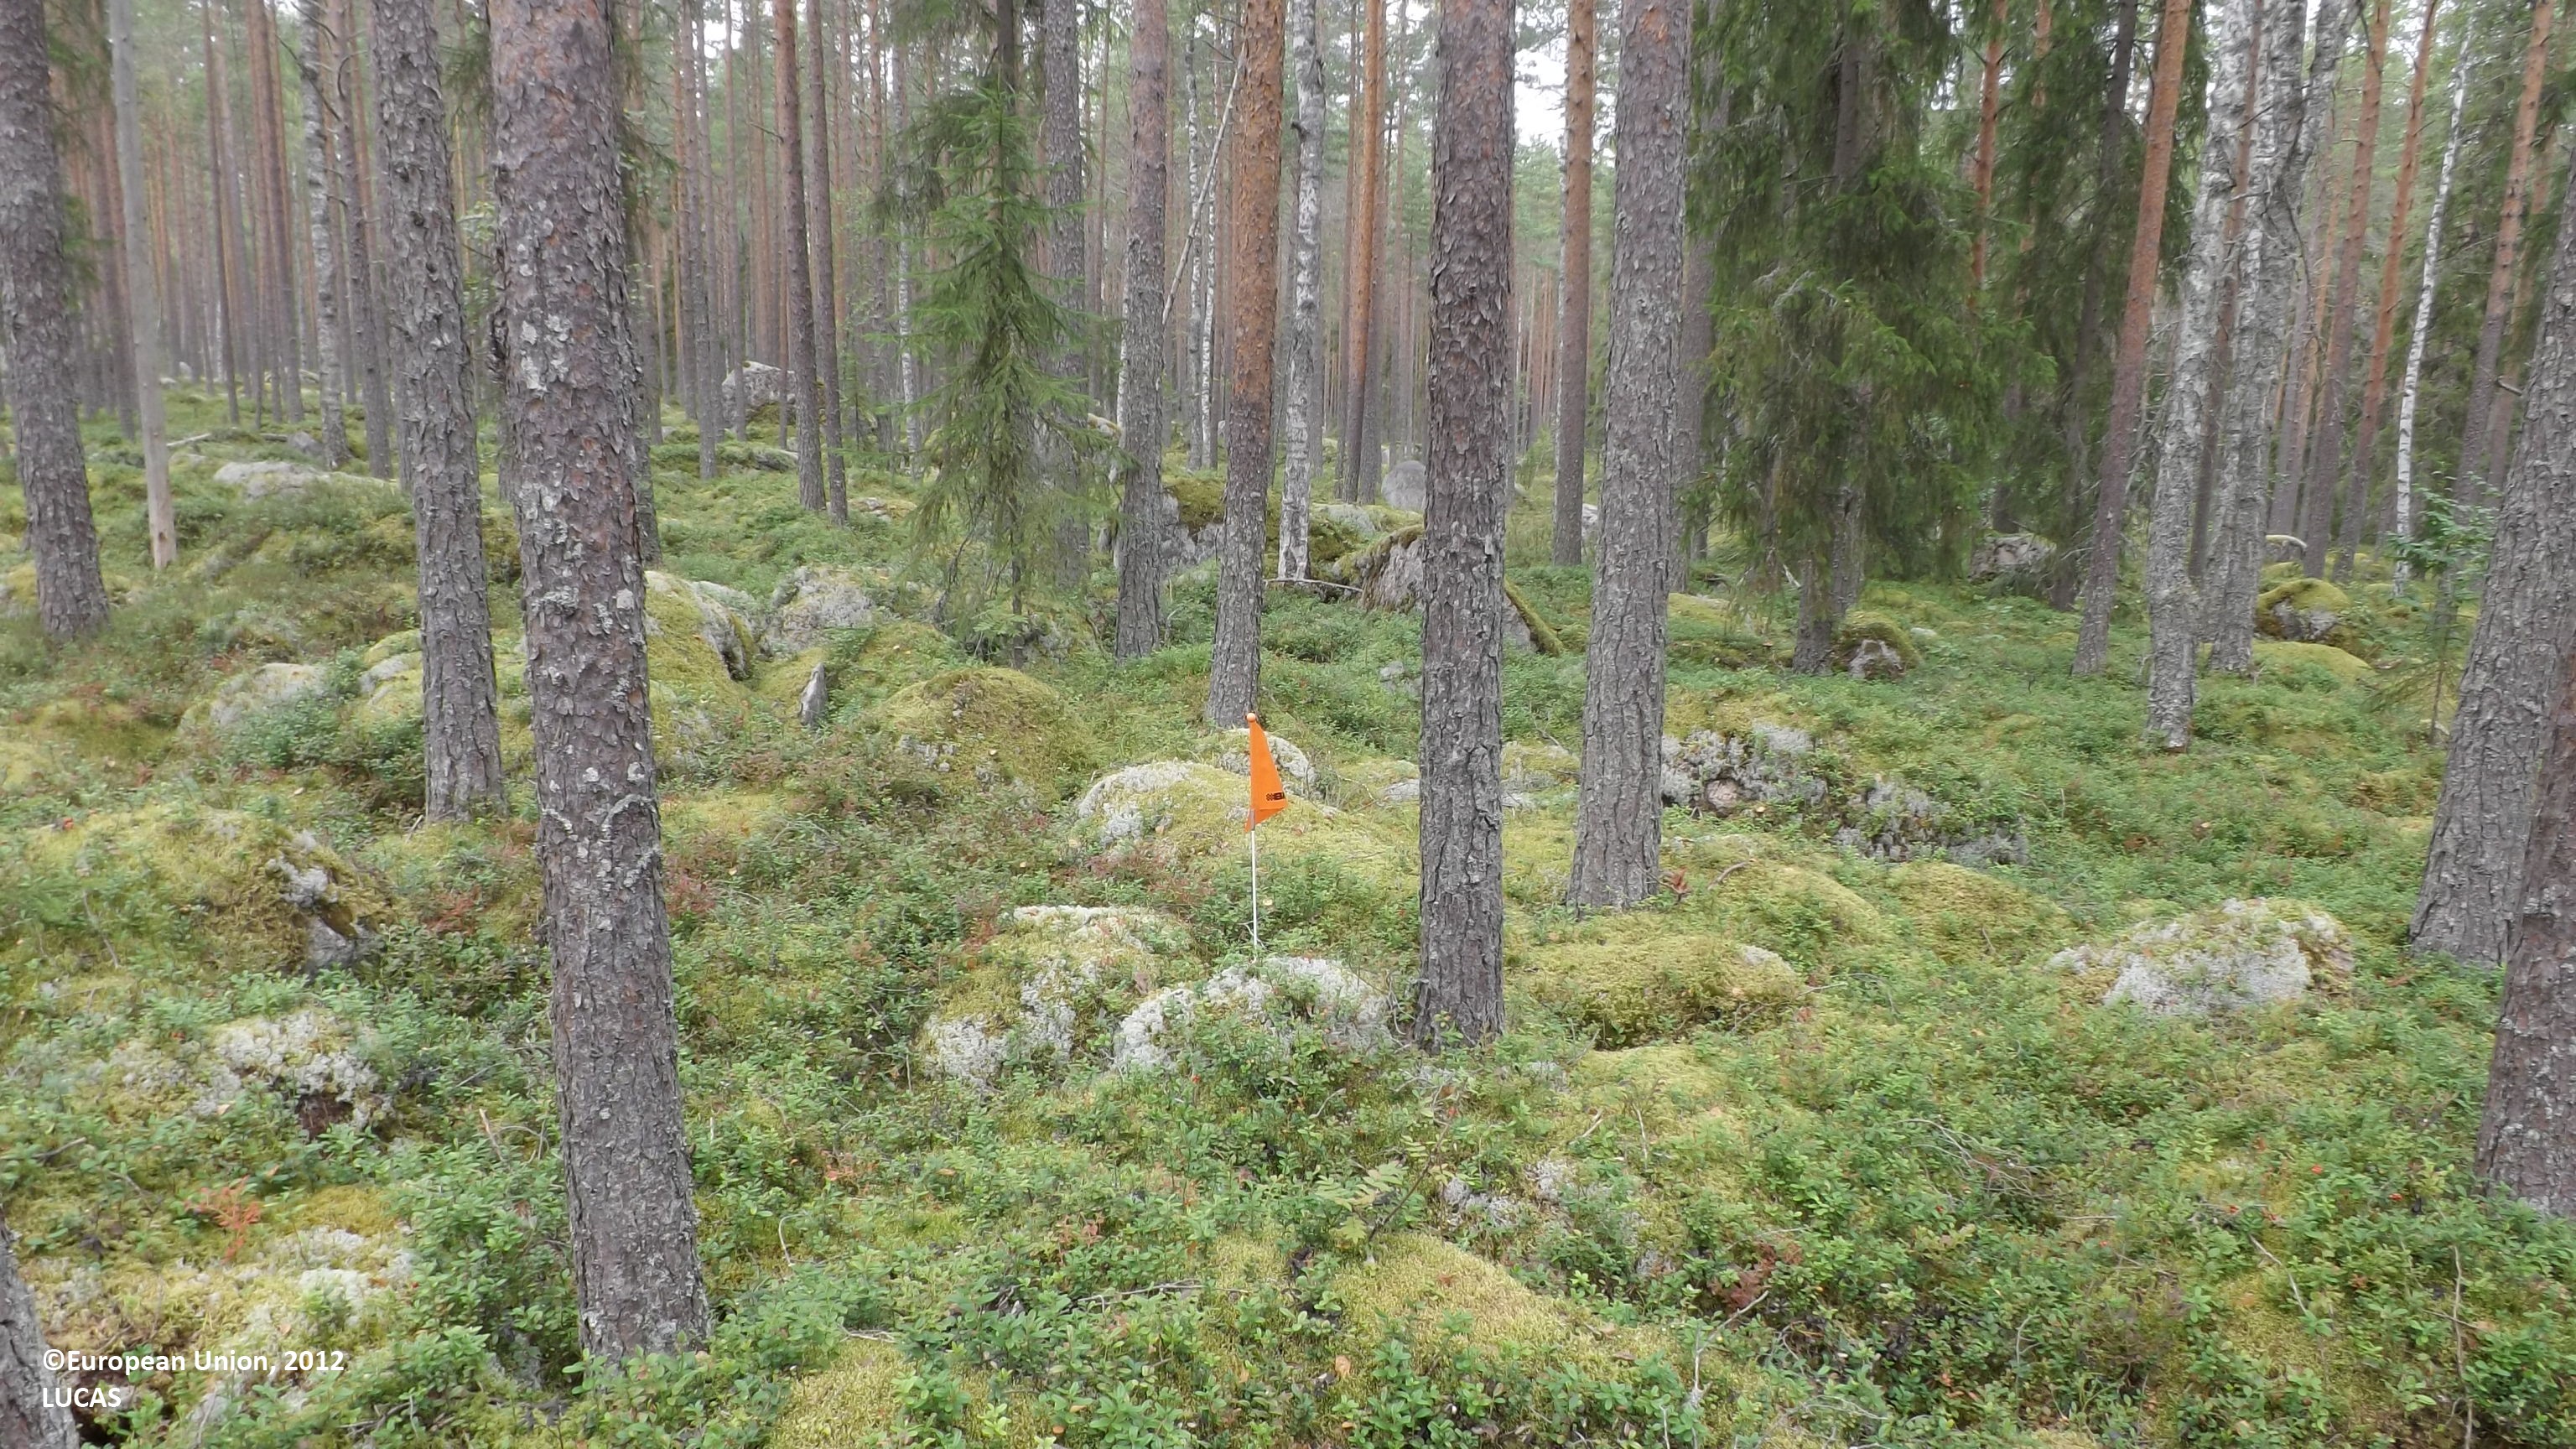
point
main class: Woodland
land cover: Pine dominated coniferous woodland
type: boreal forest
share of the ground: 50 - 75 %
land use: Forestry
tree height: > 5 m
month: August
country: FI
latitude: 63.9672
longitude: 24.0973
